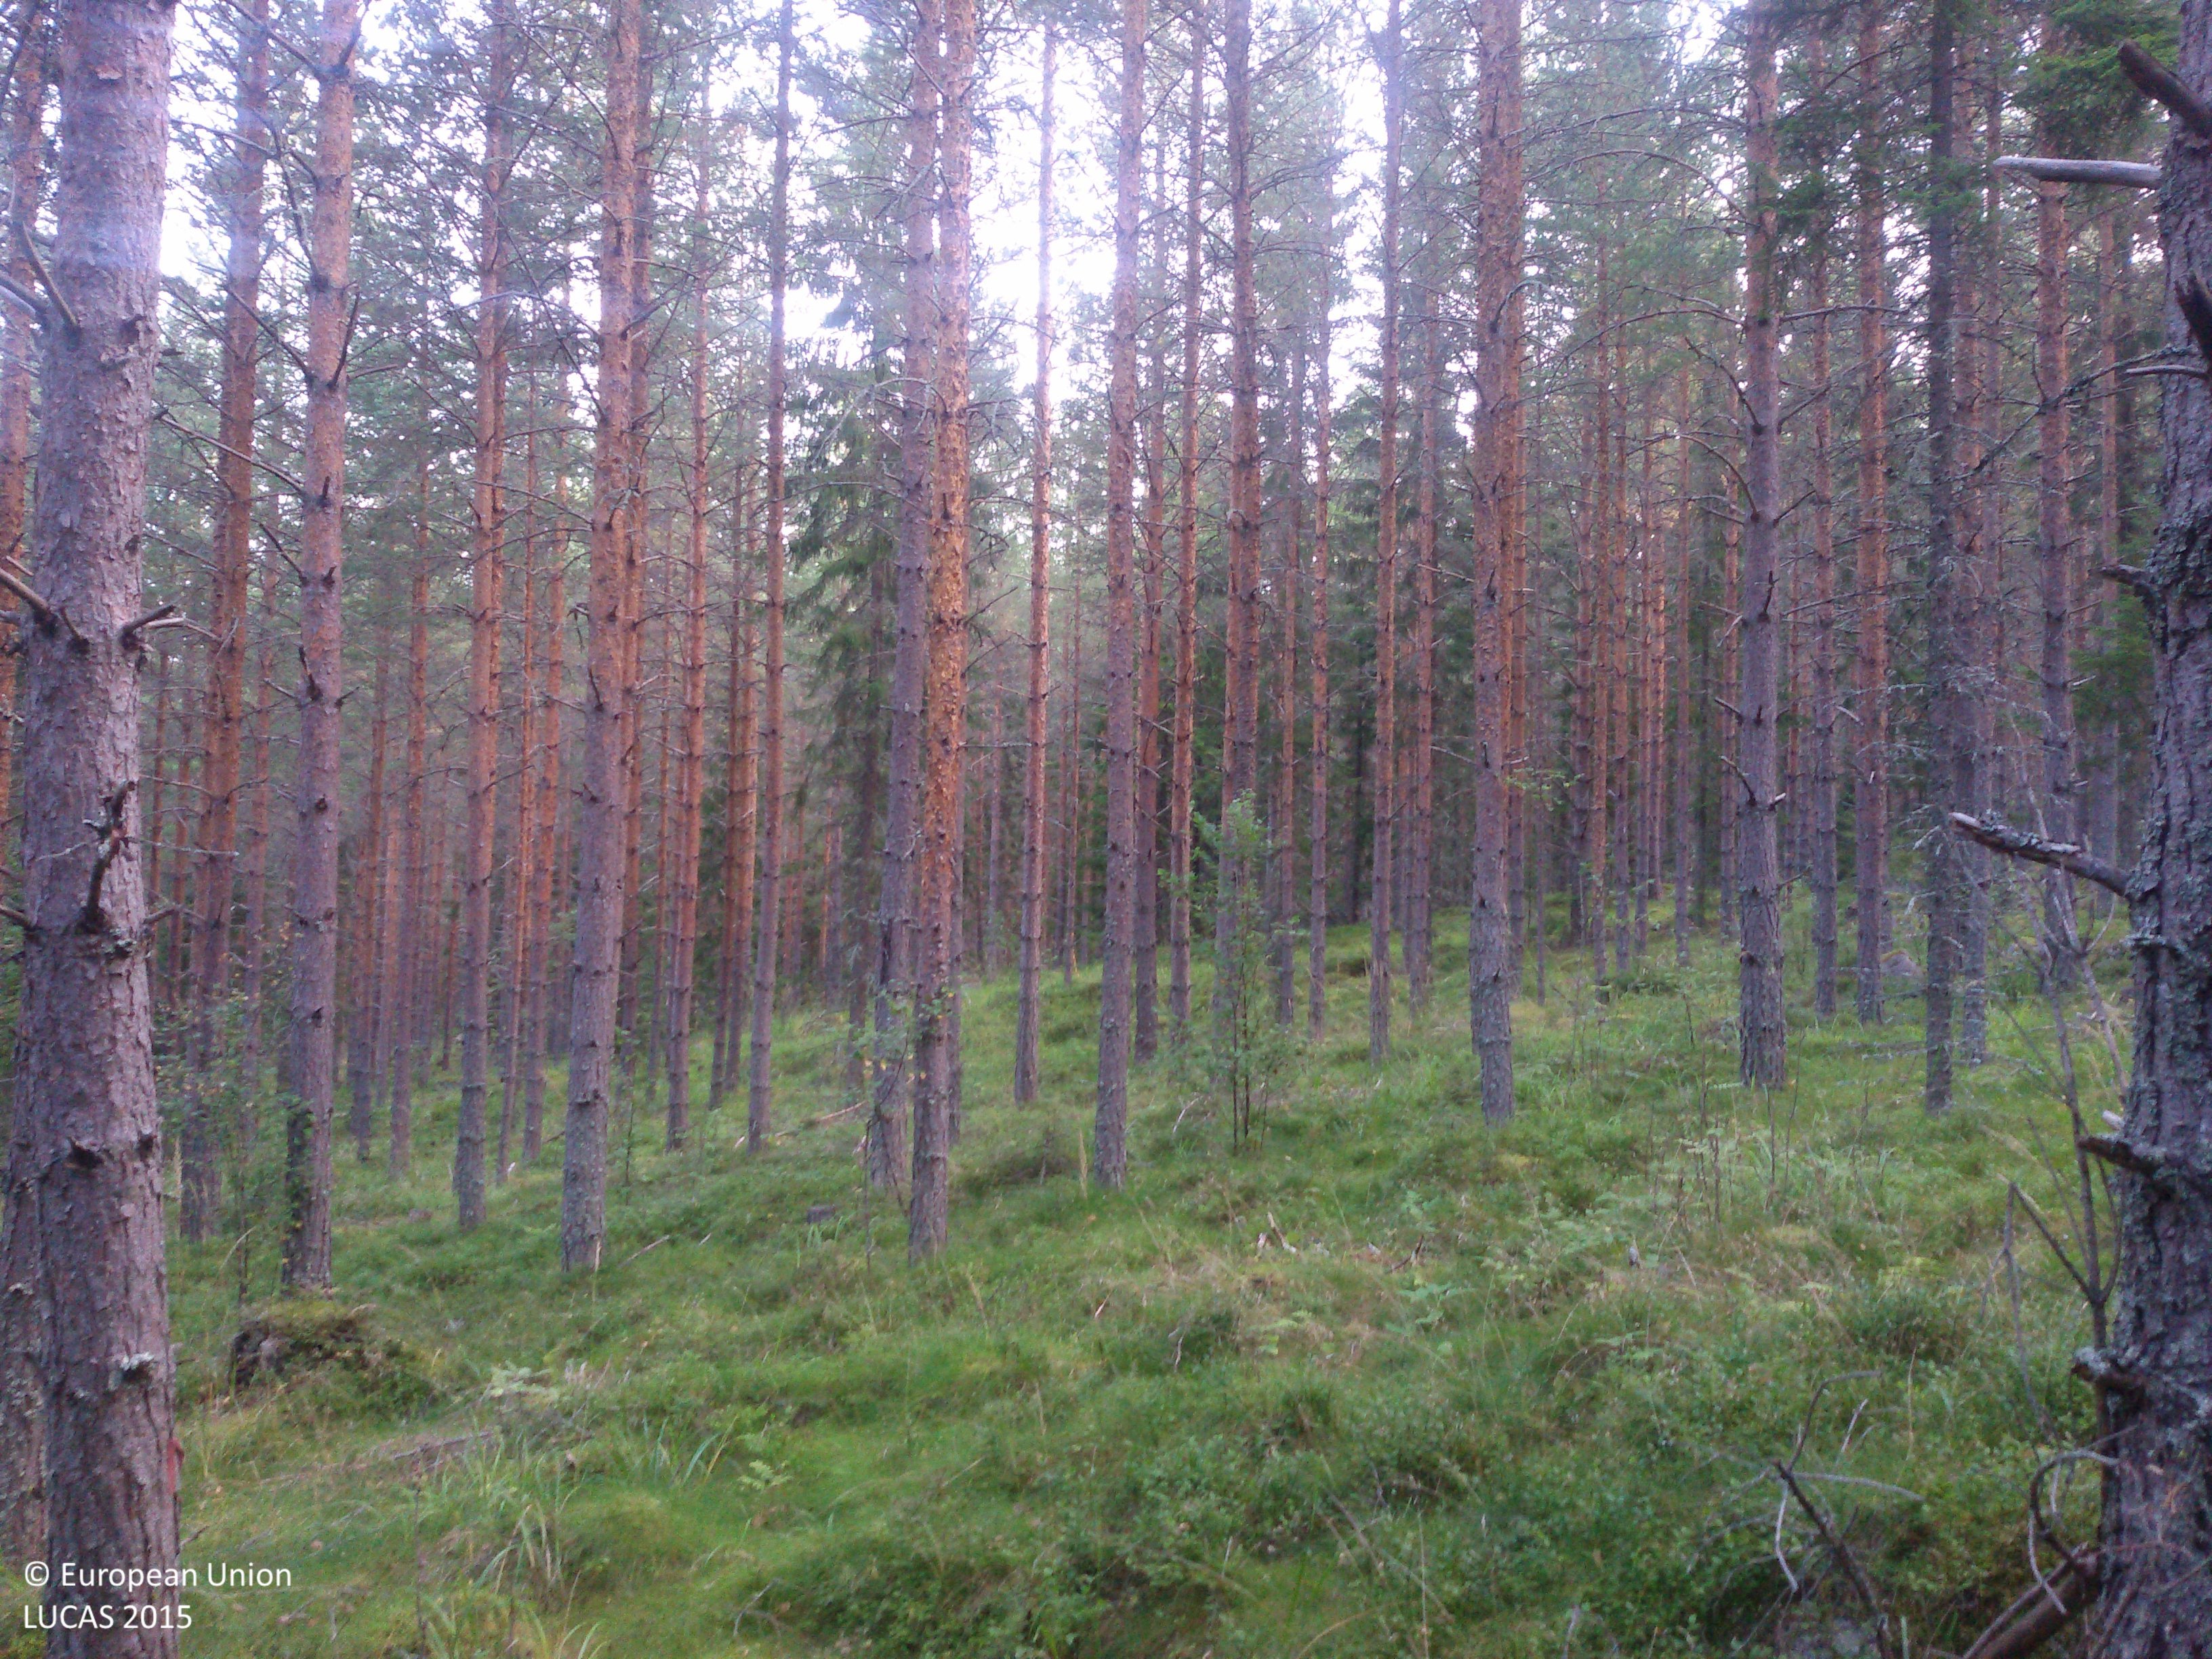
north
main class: Woodland
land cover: Pine dominated coniferous woodland
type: boreal forest
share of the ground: 50 - 75 %
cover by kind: coniferous forest trees 75 %, shrubs 10 %, lichens and mosses 10 %, herbaceous plants 5 %
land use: Forestry
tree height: > 5 m
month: August
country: SE
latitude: 60.7236
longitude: 15.9449
